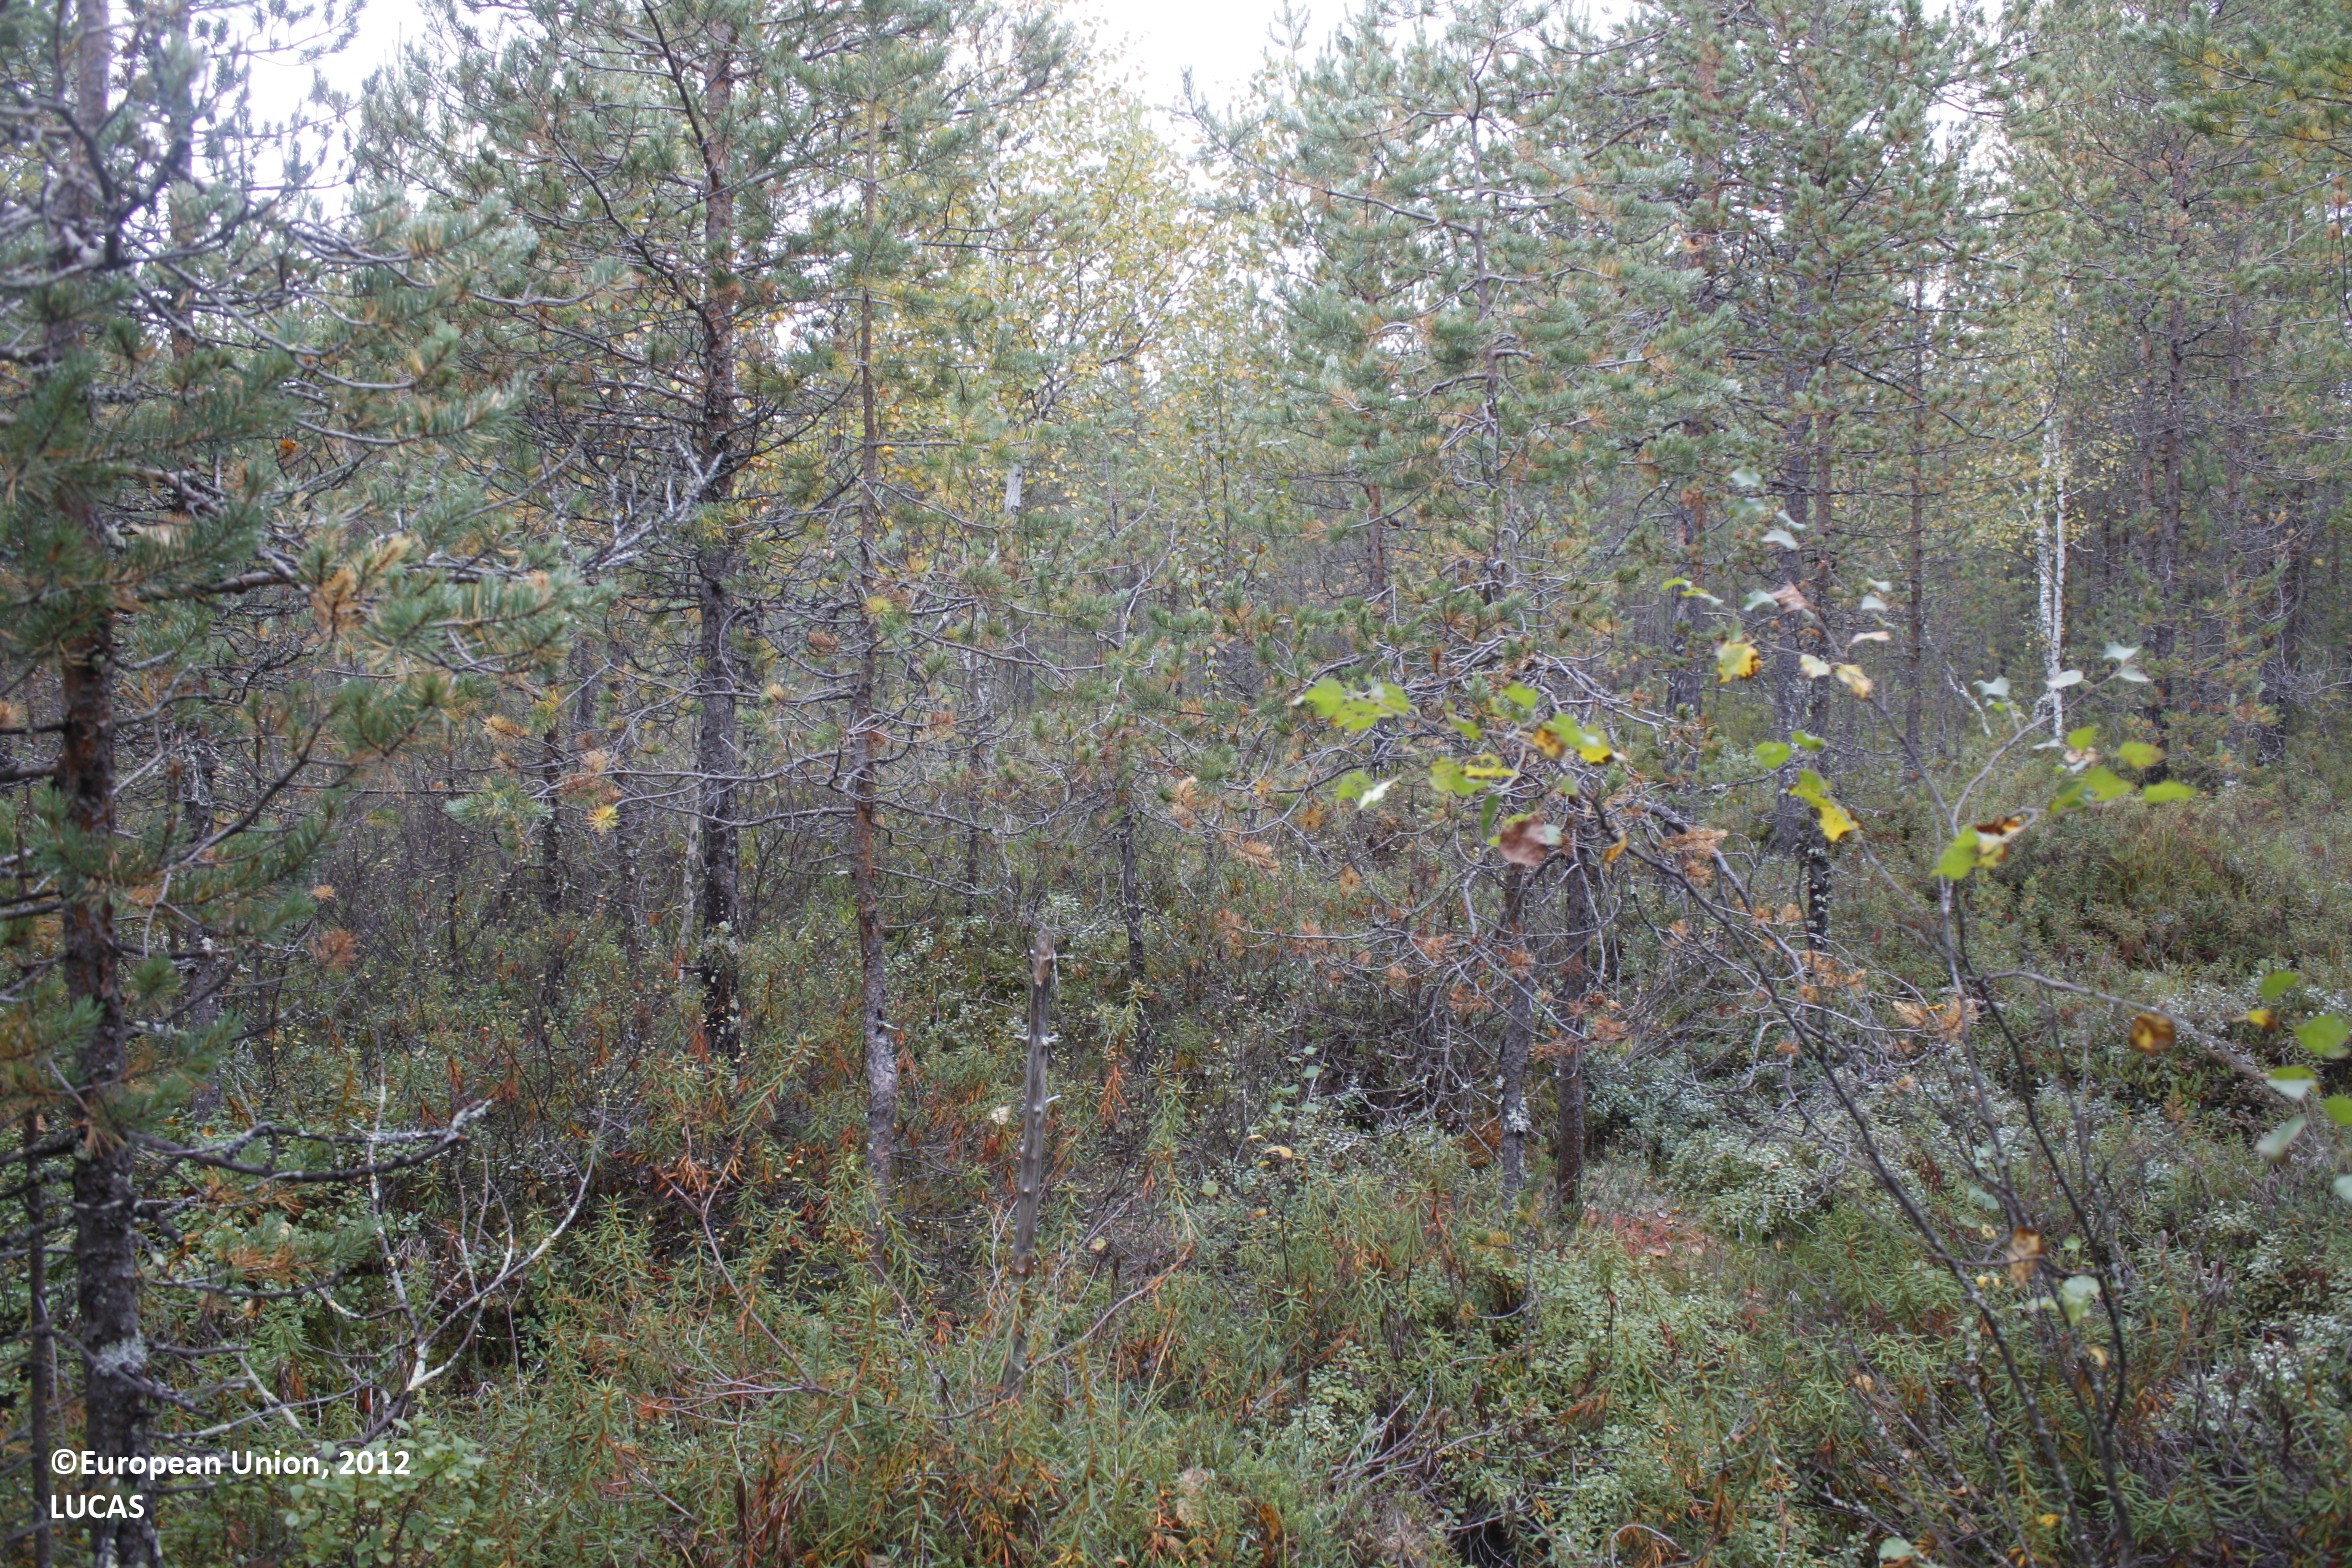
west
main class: Woodland
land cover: Pine dominated coniferous woodland
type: boreal forest
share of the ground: 50 - 75 %
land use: Forestry
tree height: > 5 m
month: September
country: FI
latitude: 65.1487
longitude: 26.7682
